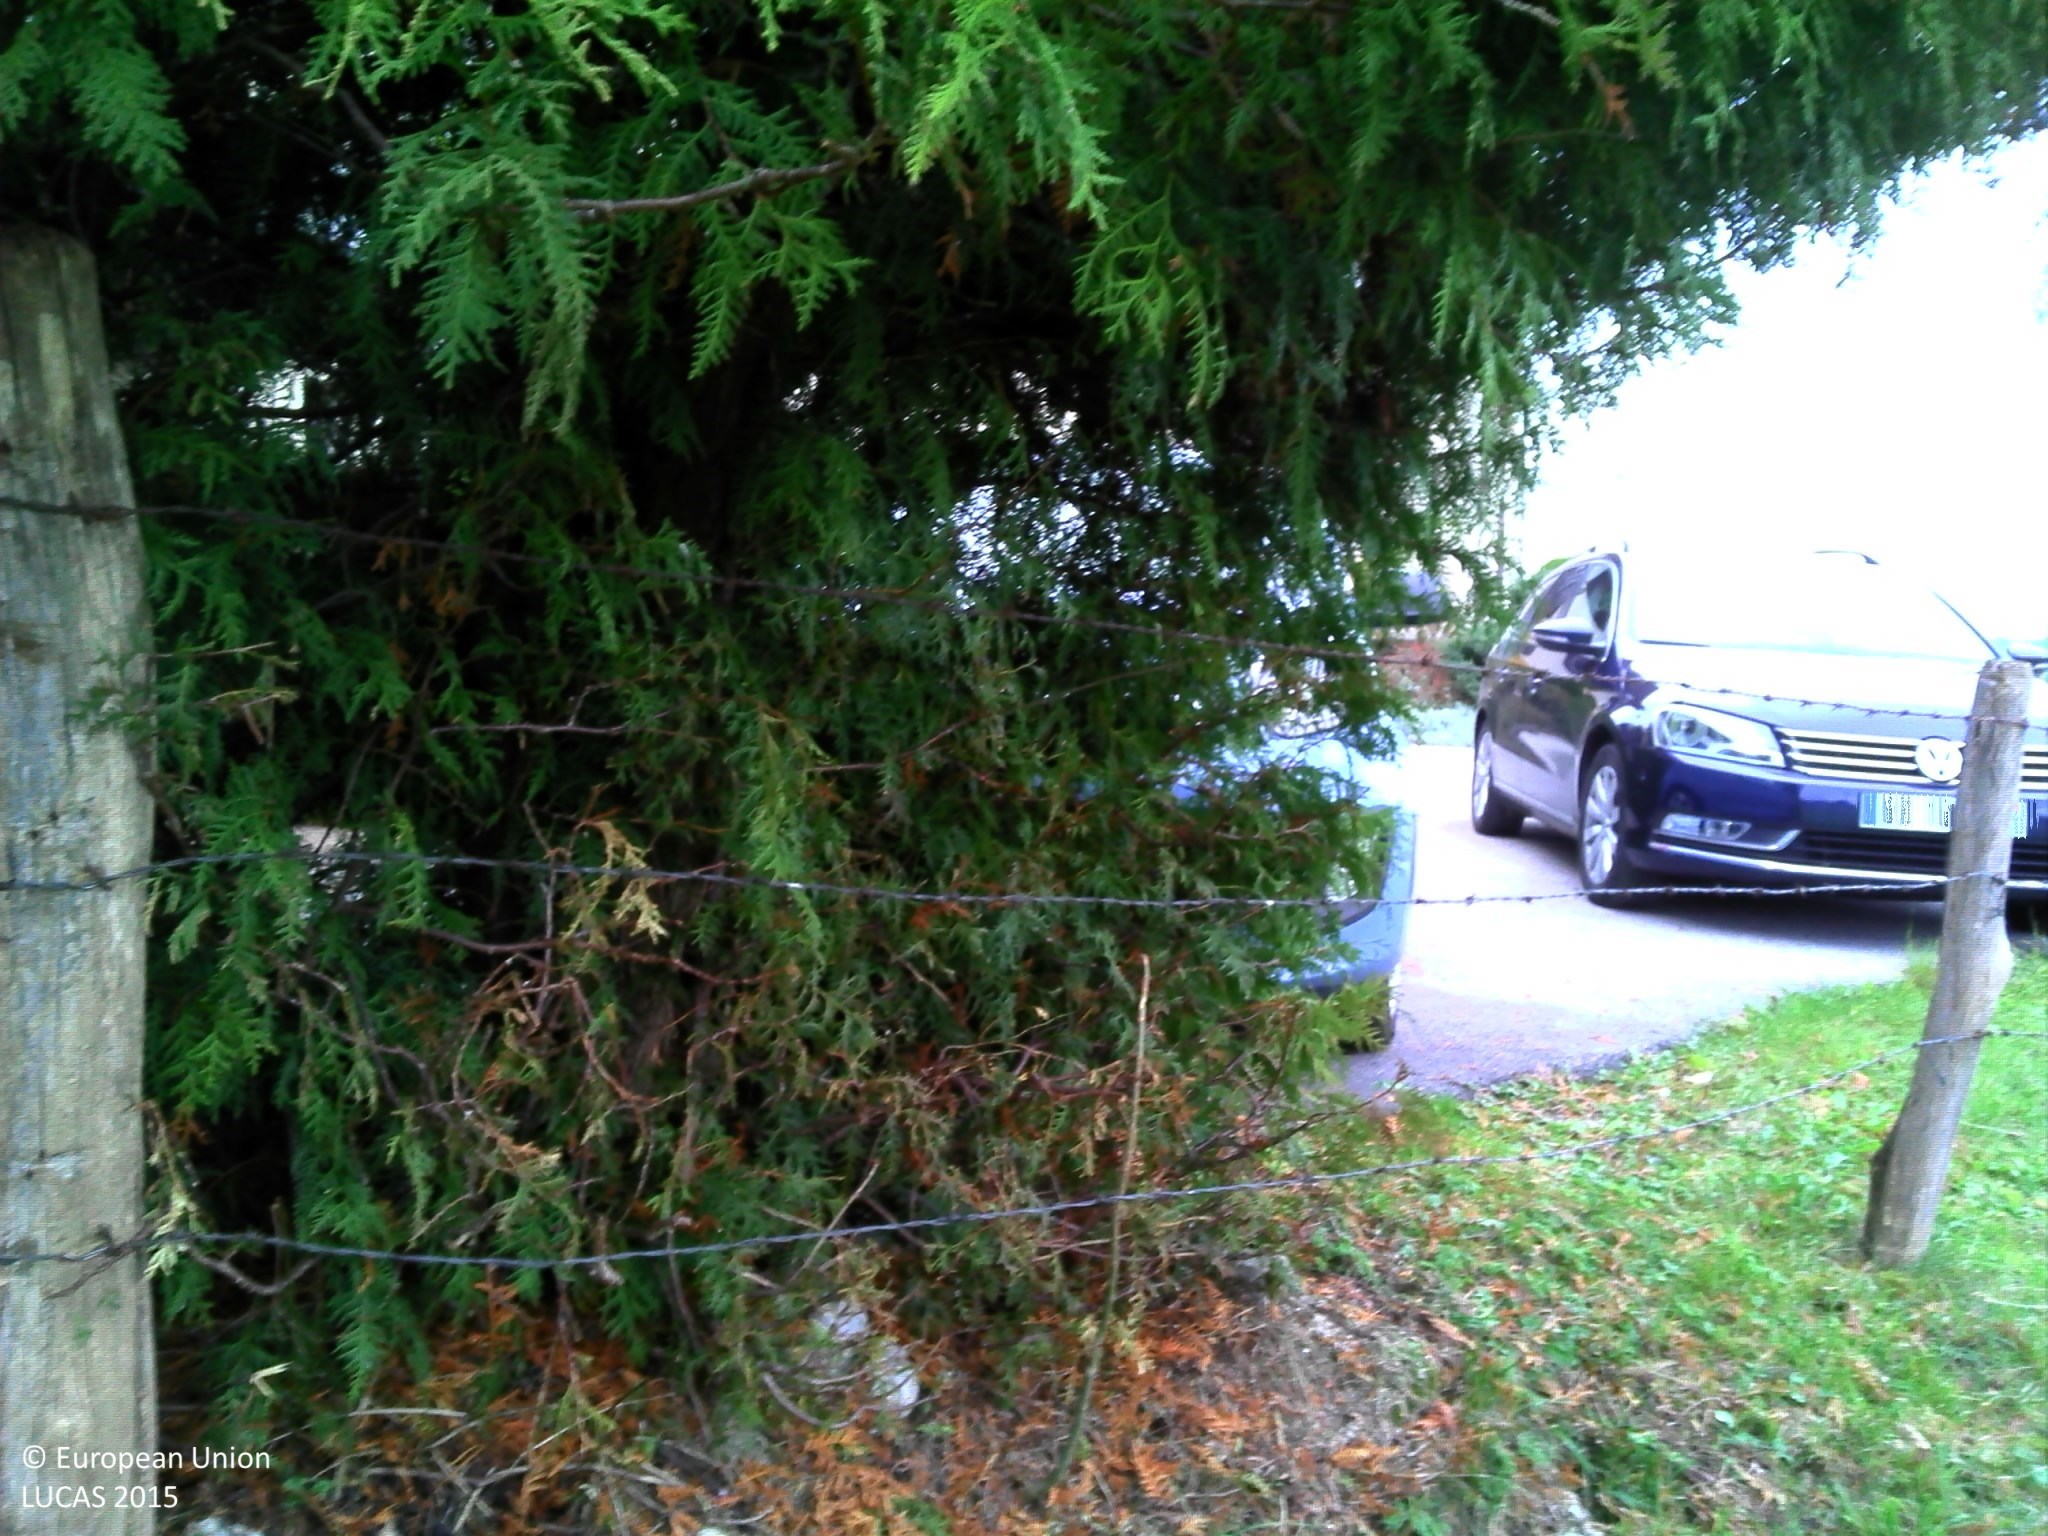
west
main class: Grassland
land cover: Grassland without tree/shrub cover
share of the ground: > 75 %
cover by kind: herbaceous plants 100 %
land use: Agriculture (excluding fallow land and kitchen gardens)
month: October
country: FR
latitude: 46.7370
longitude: 6.2728
